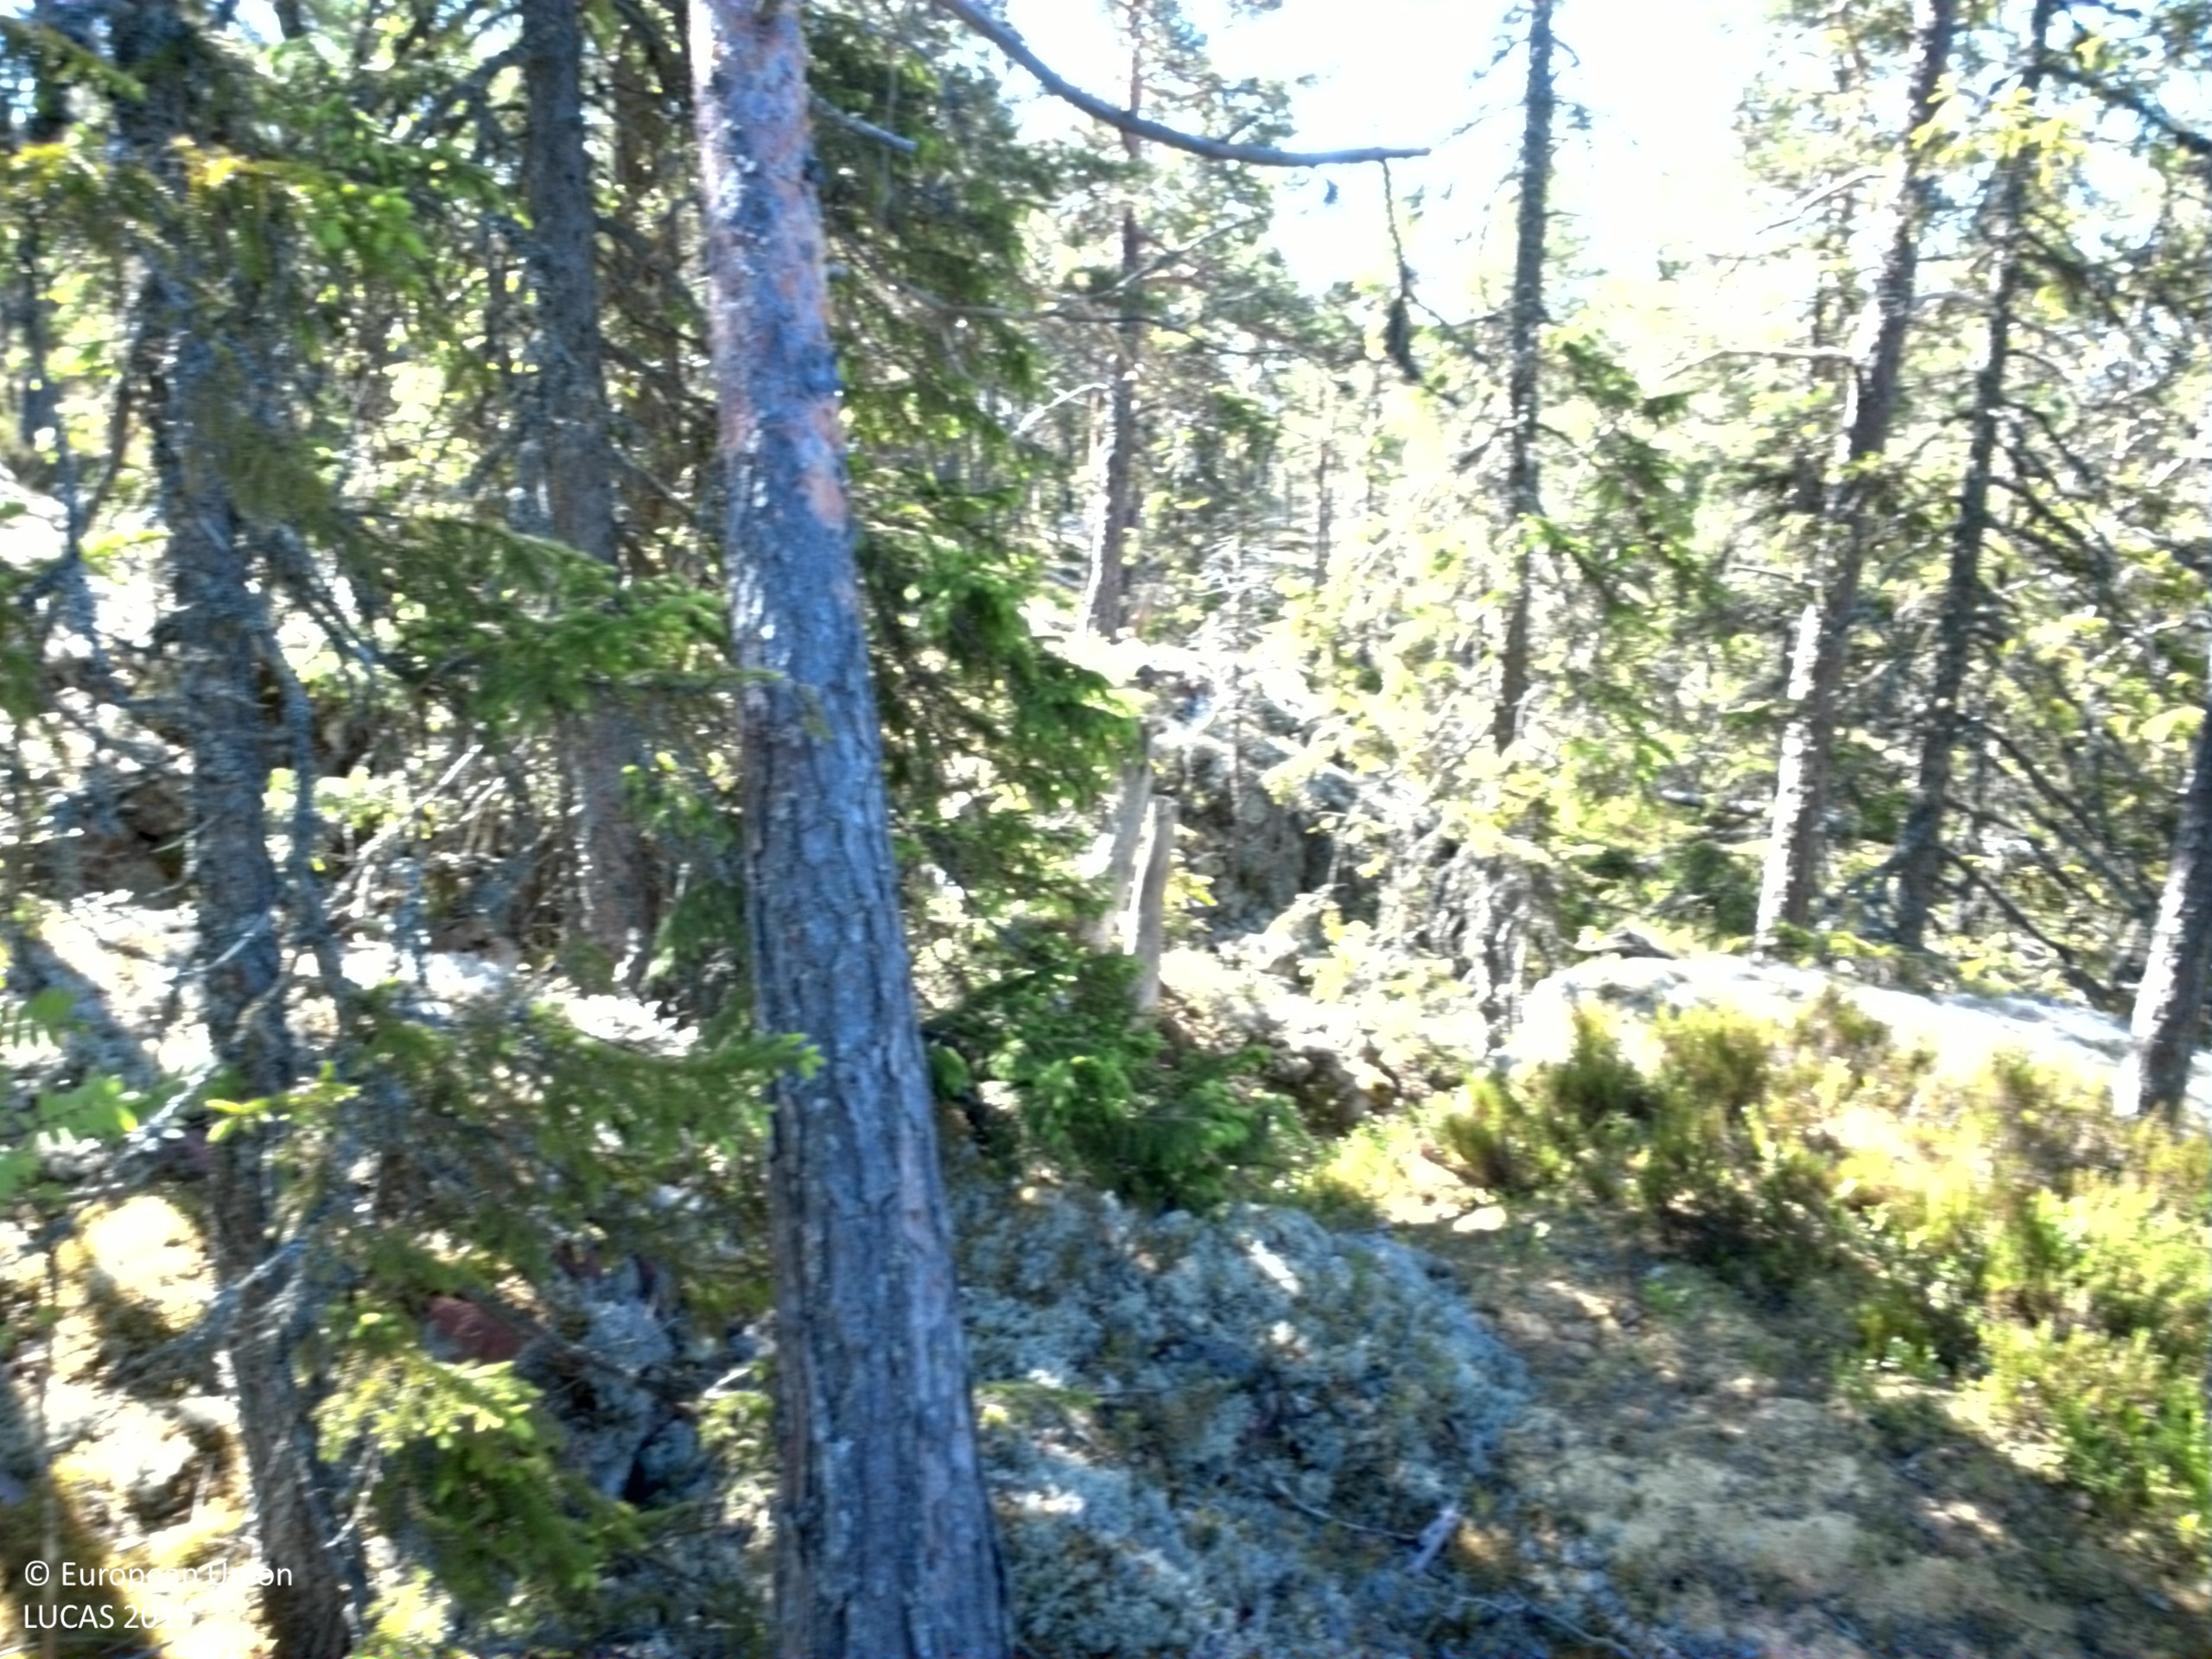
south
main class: Woodland
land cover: Pine dominated coniferous woodland
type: boreal forest
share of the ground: 50 - 75 %
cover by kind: coniferous forest trees 45 %, lichens and mosses 35 %, shrubs 10 %, consolidated bare surface 10 %
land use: Semi-natural and natural areas not in use
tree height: > 5 m
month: June
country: SE
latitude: 63.0457
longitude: 18.4624
